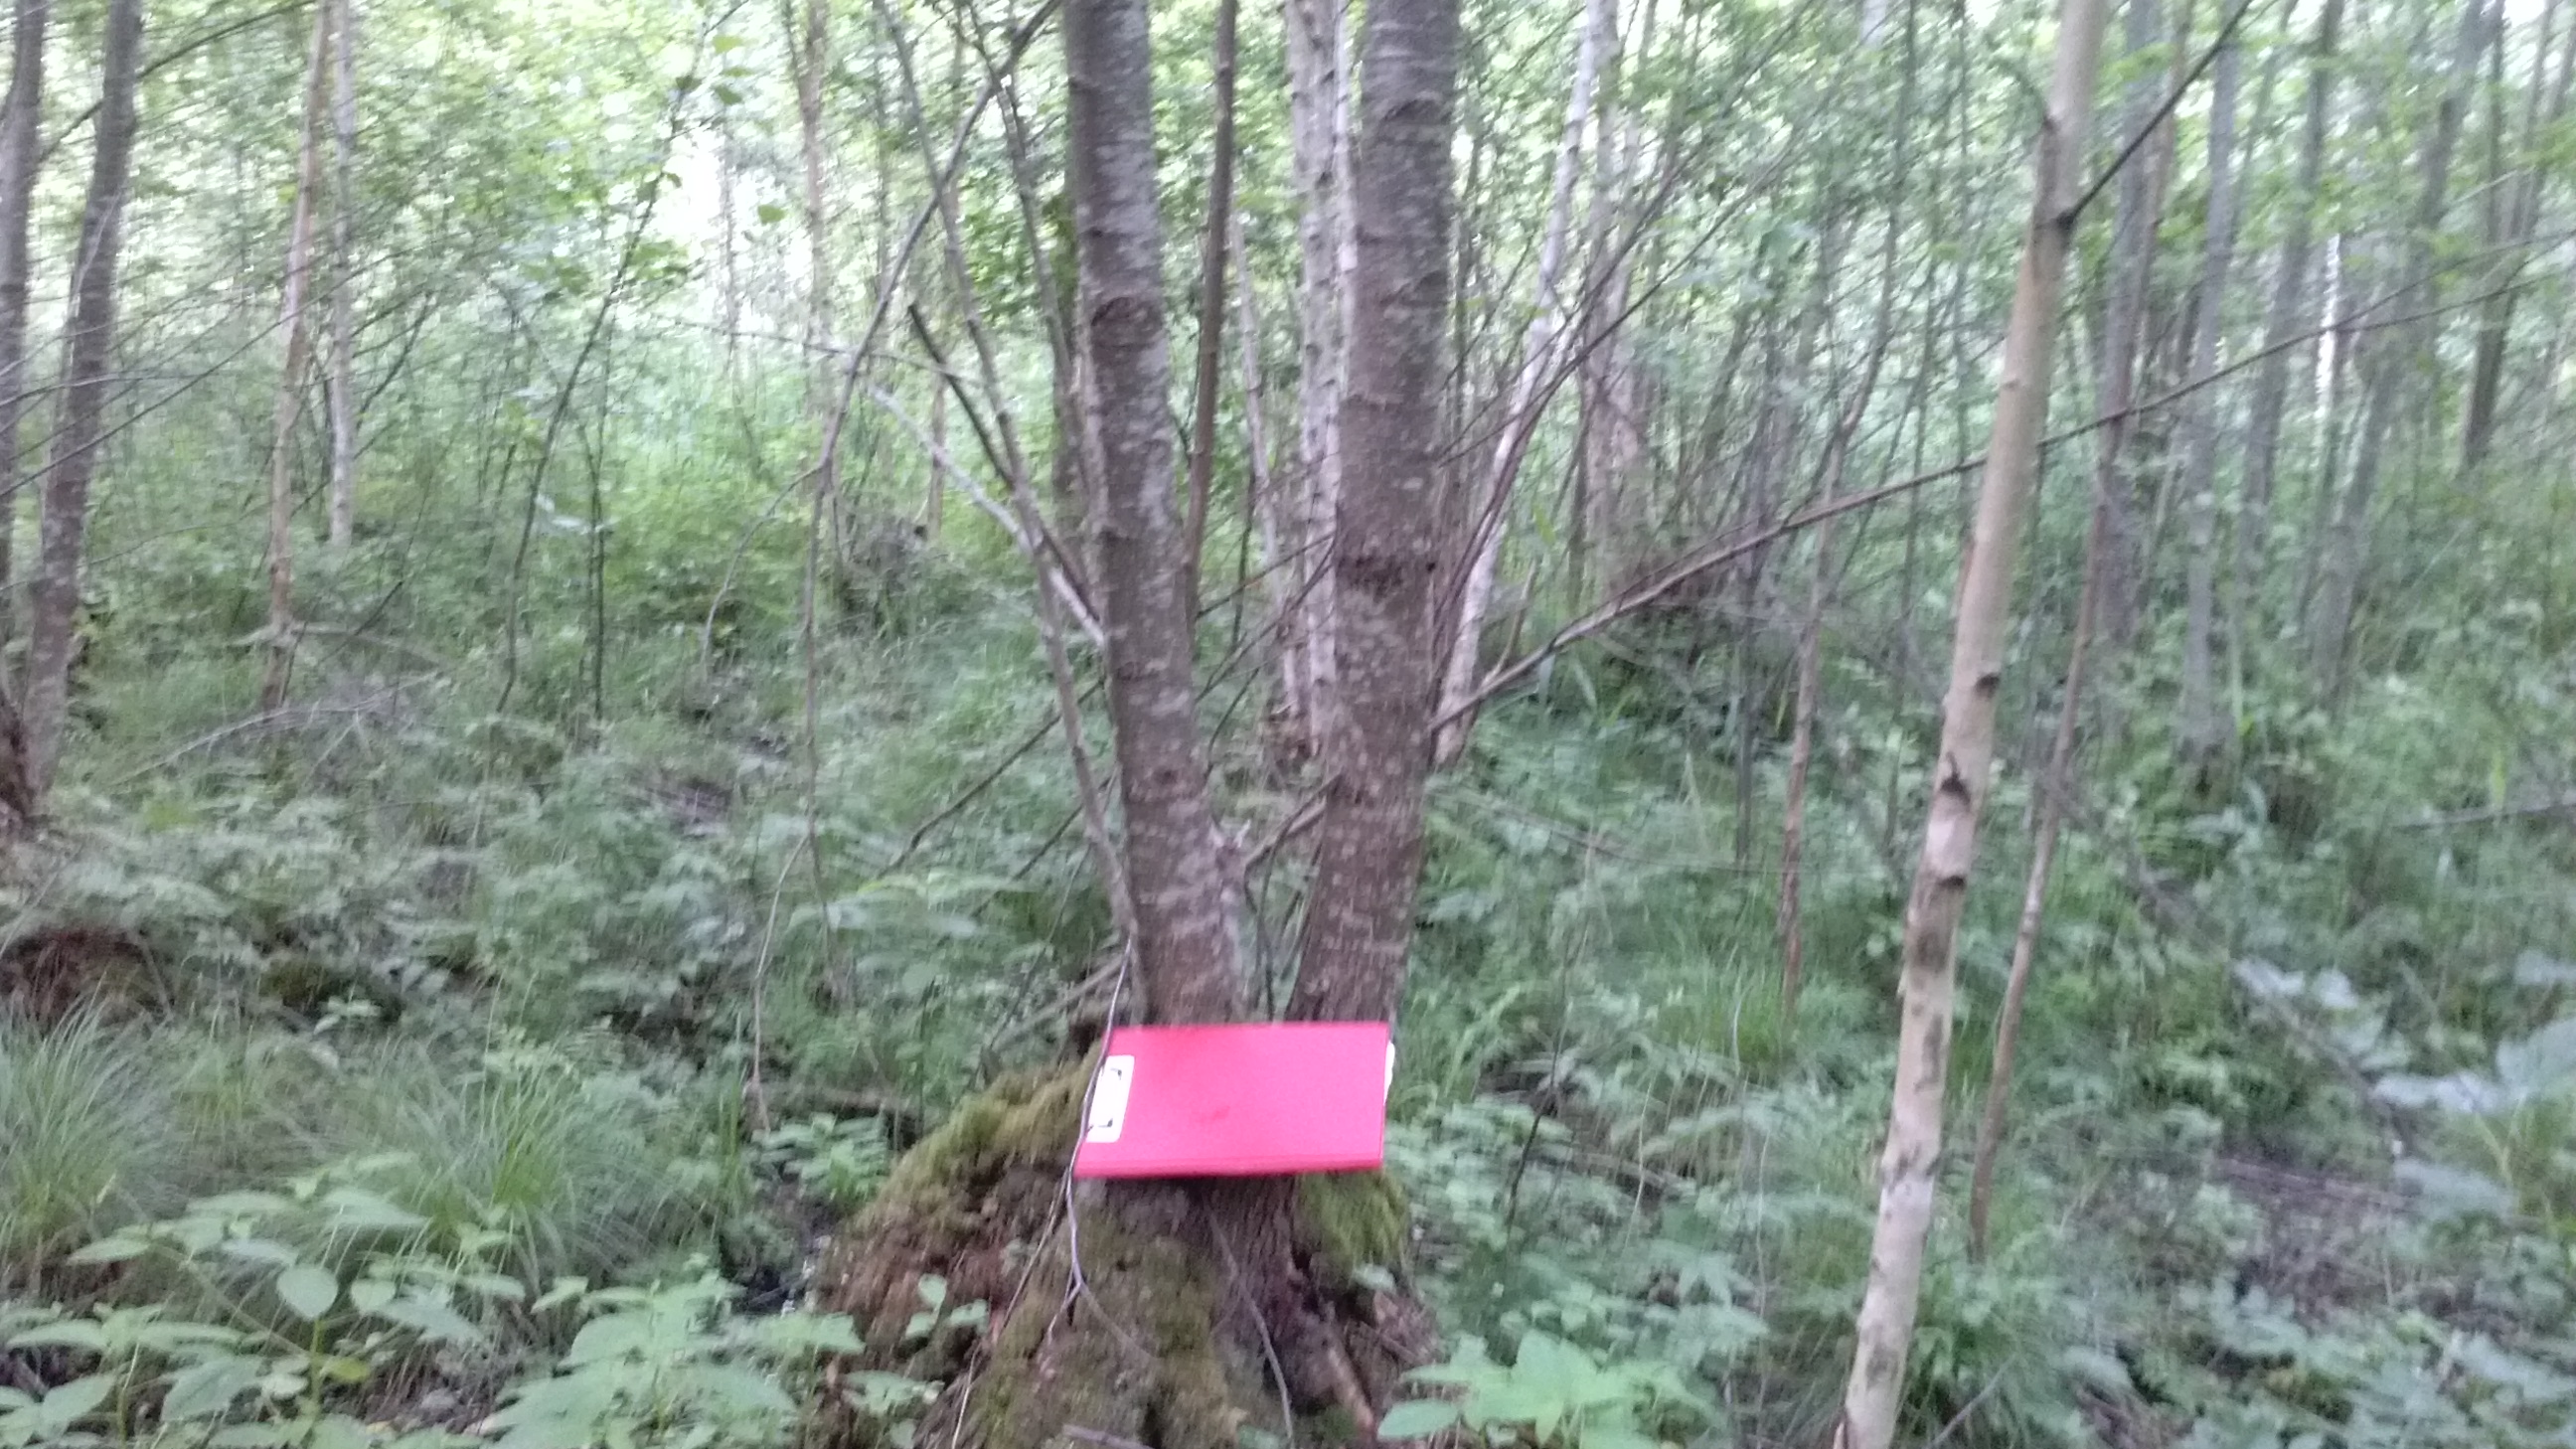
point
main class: Woodland
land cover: Broadleaved woodland
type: non-riverine alder, birch or aspen forest
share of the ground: > 75 %
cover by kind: broadleaved forest trees 80 %, herbaceous plants 15 %, shrubs 5 %
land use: Forestry
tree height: > 5 m
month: June
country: LV
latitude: 56.6082
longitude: 27.9354
